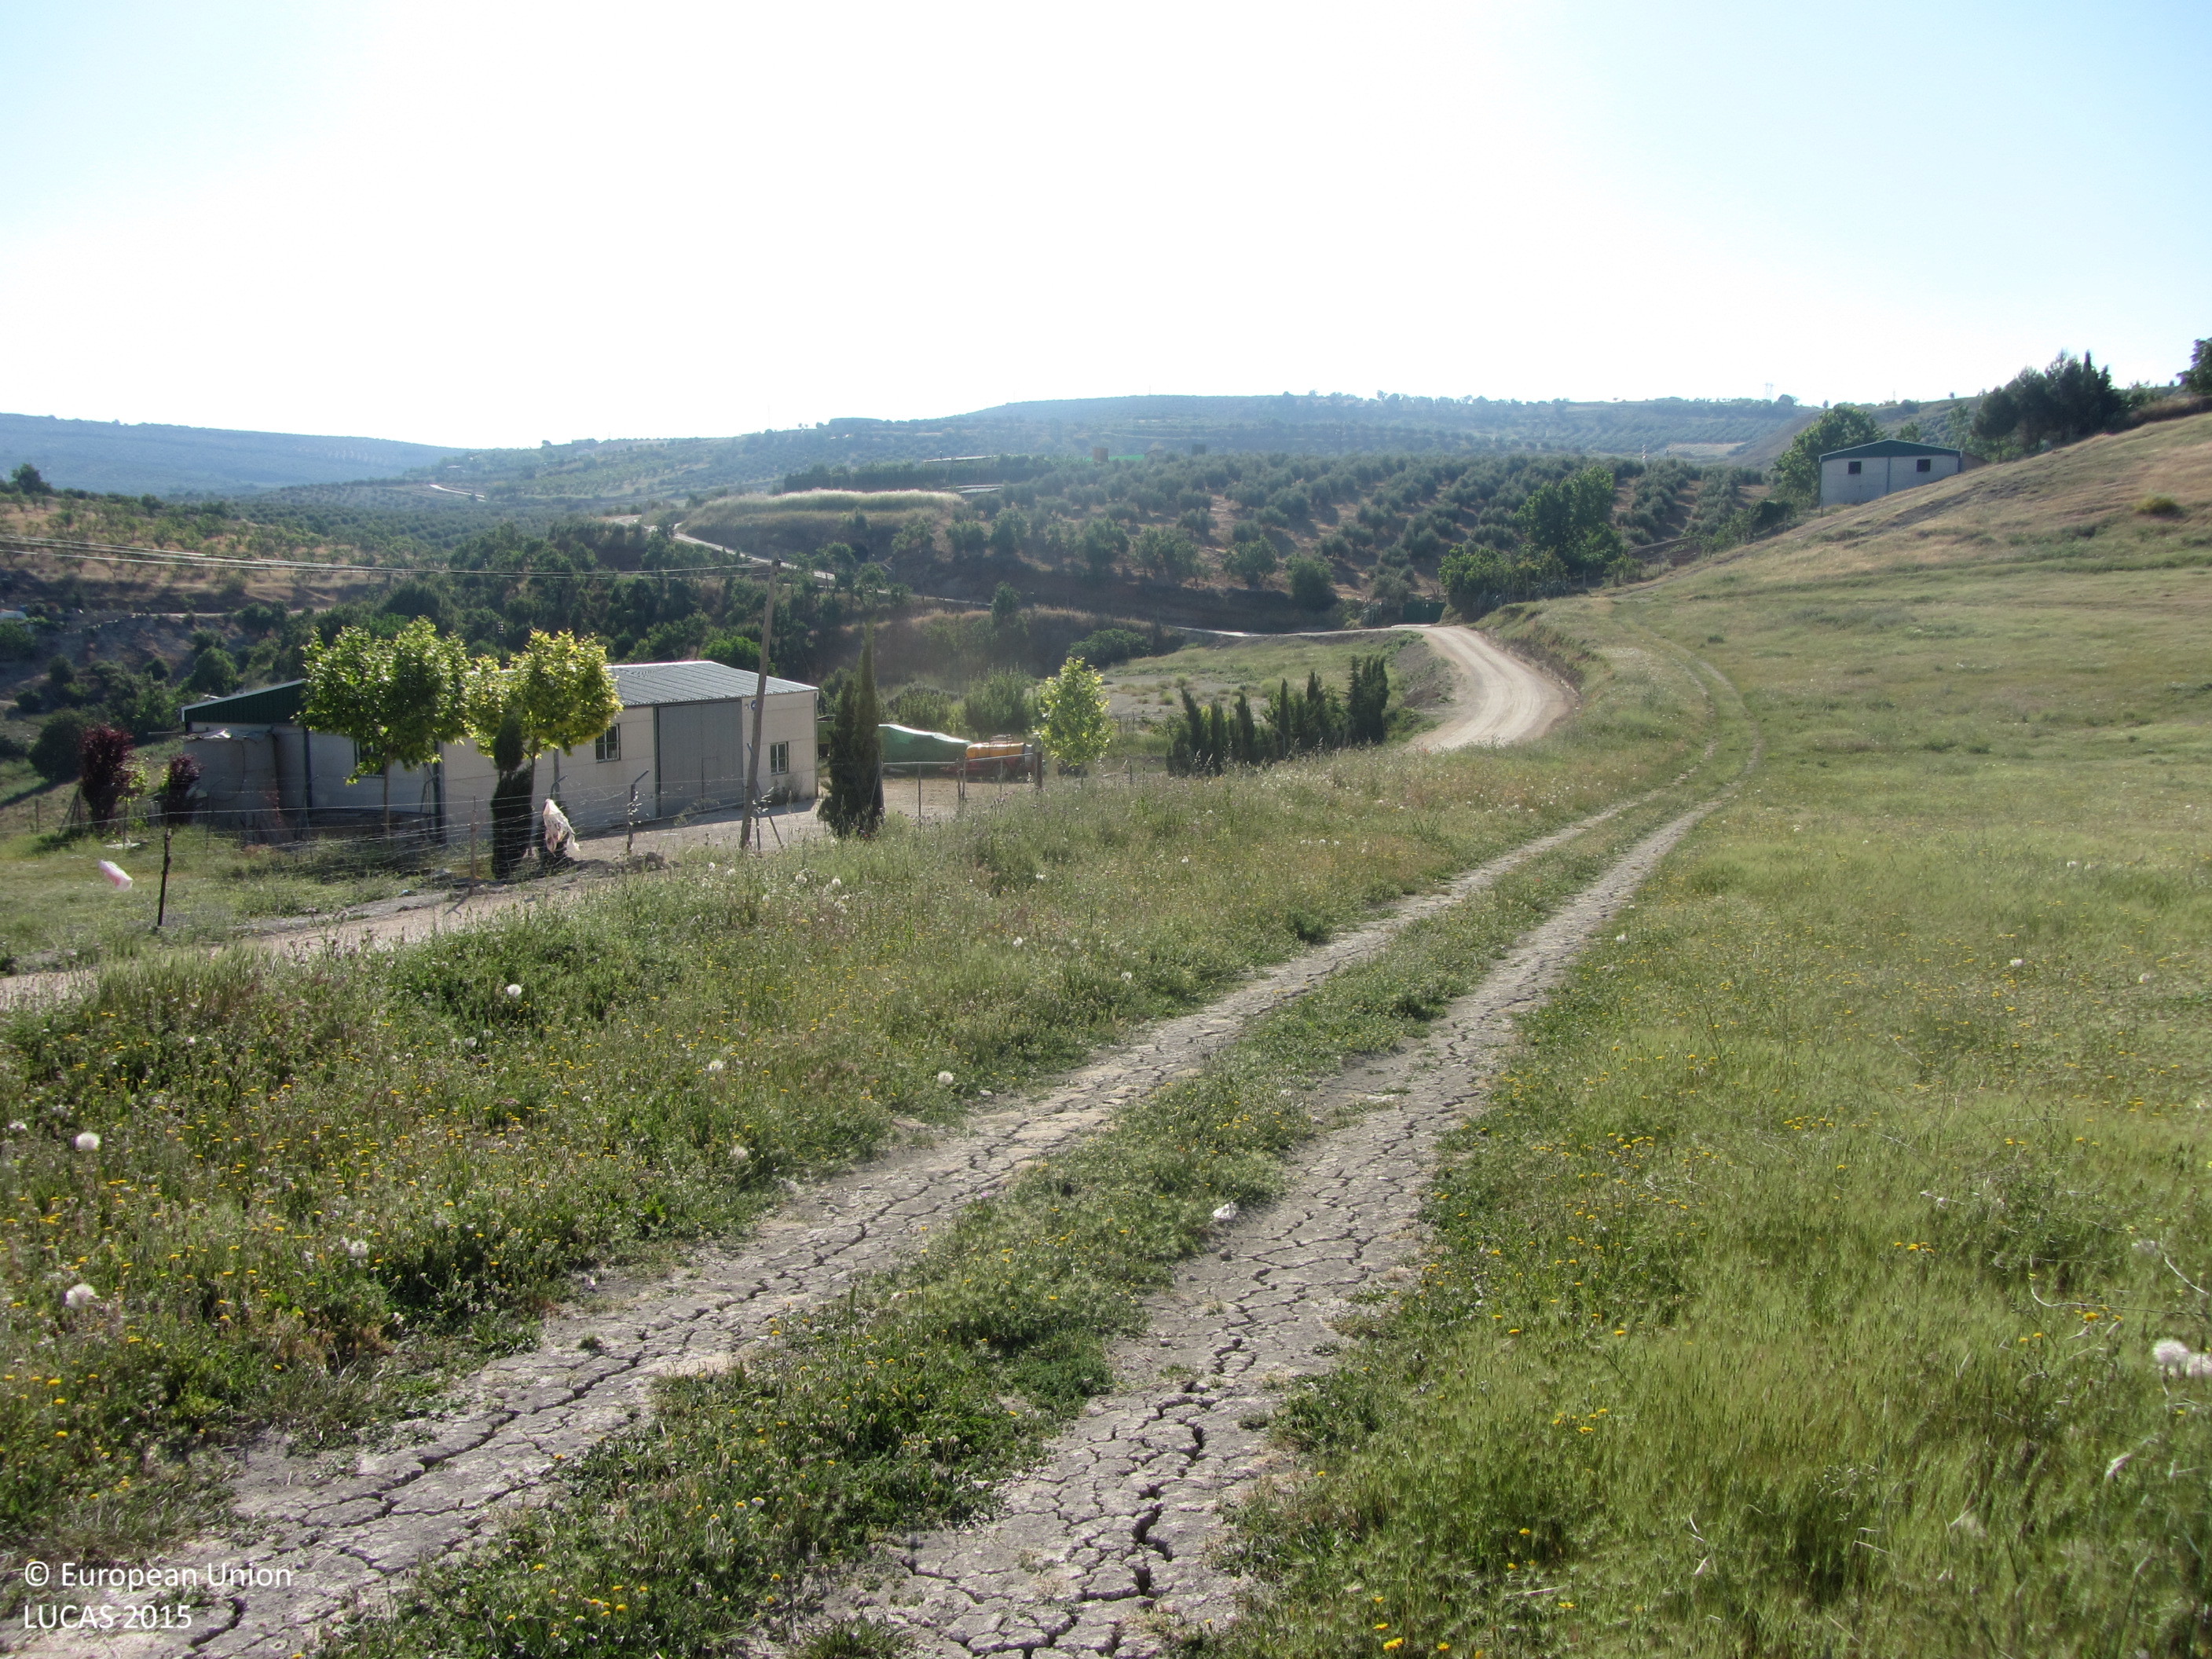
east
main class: Grassland
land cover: Grassland without tree/shrub cover
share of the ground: > 75 %
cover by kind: herbaceous plants 95 %, consolidated bare surface 5 %
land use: Semi-natural and natural areas not in use
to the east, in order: Grassland without tree/shrub cover; Tracks; Grass margins; Fences; Ditches and canals; Tracks; Fences; Artificial constructions in urban areas; Spontaneously vegetated surfaces; Nuts trees; Fences; Grassland without tree/shrub cover; Rivers and streams; Fences; Nuts trees; Fences; Tracks; Ditches and canals; Nuts trees; Spontaneously vegetated surfaces; Fences; Artificial constructions in urban areas
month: May
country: ES
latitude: 38.1713
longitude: -3.0001
